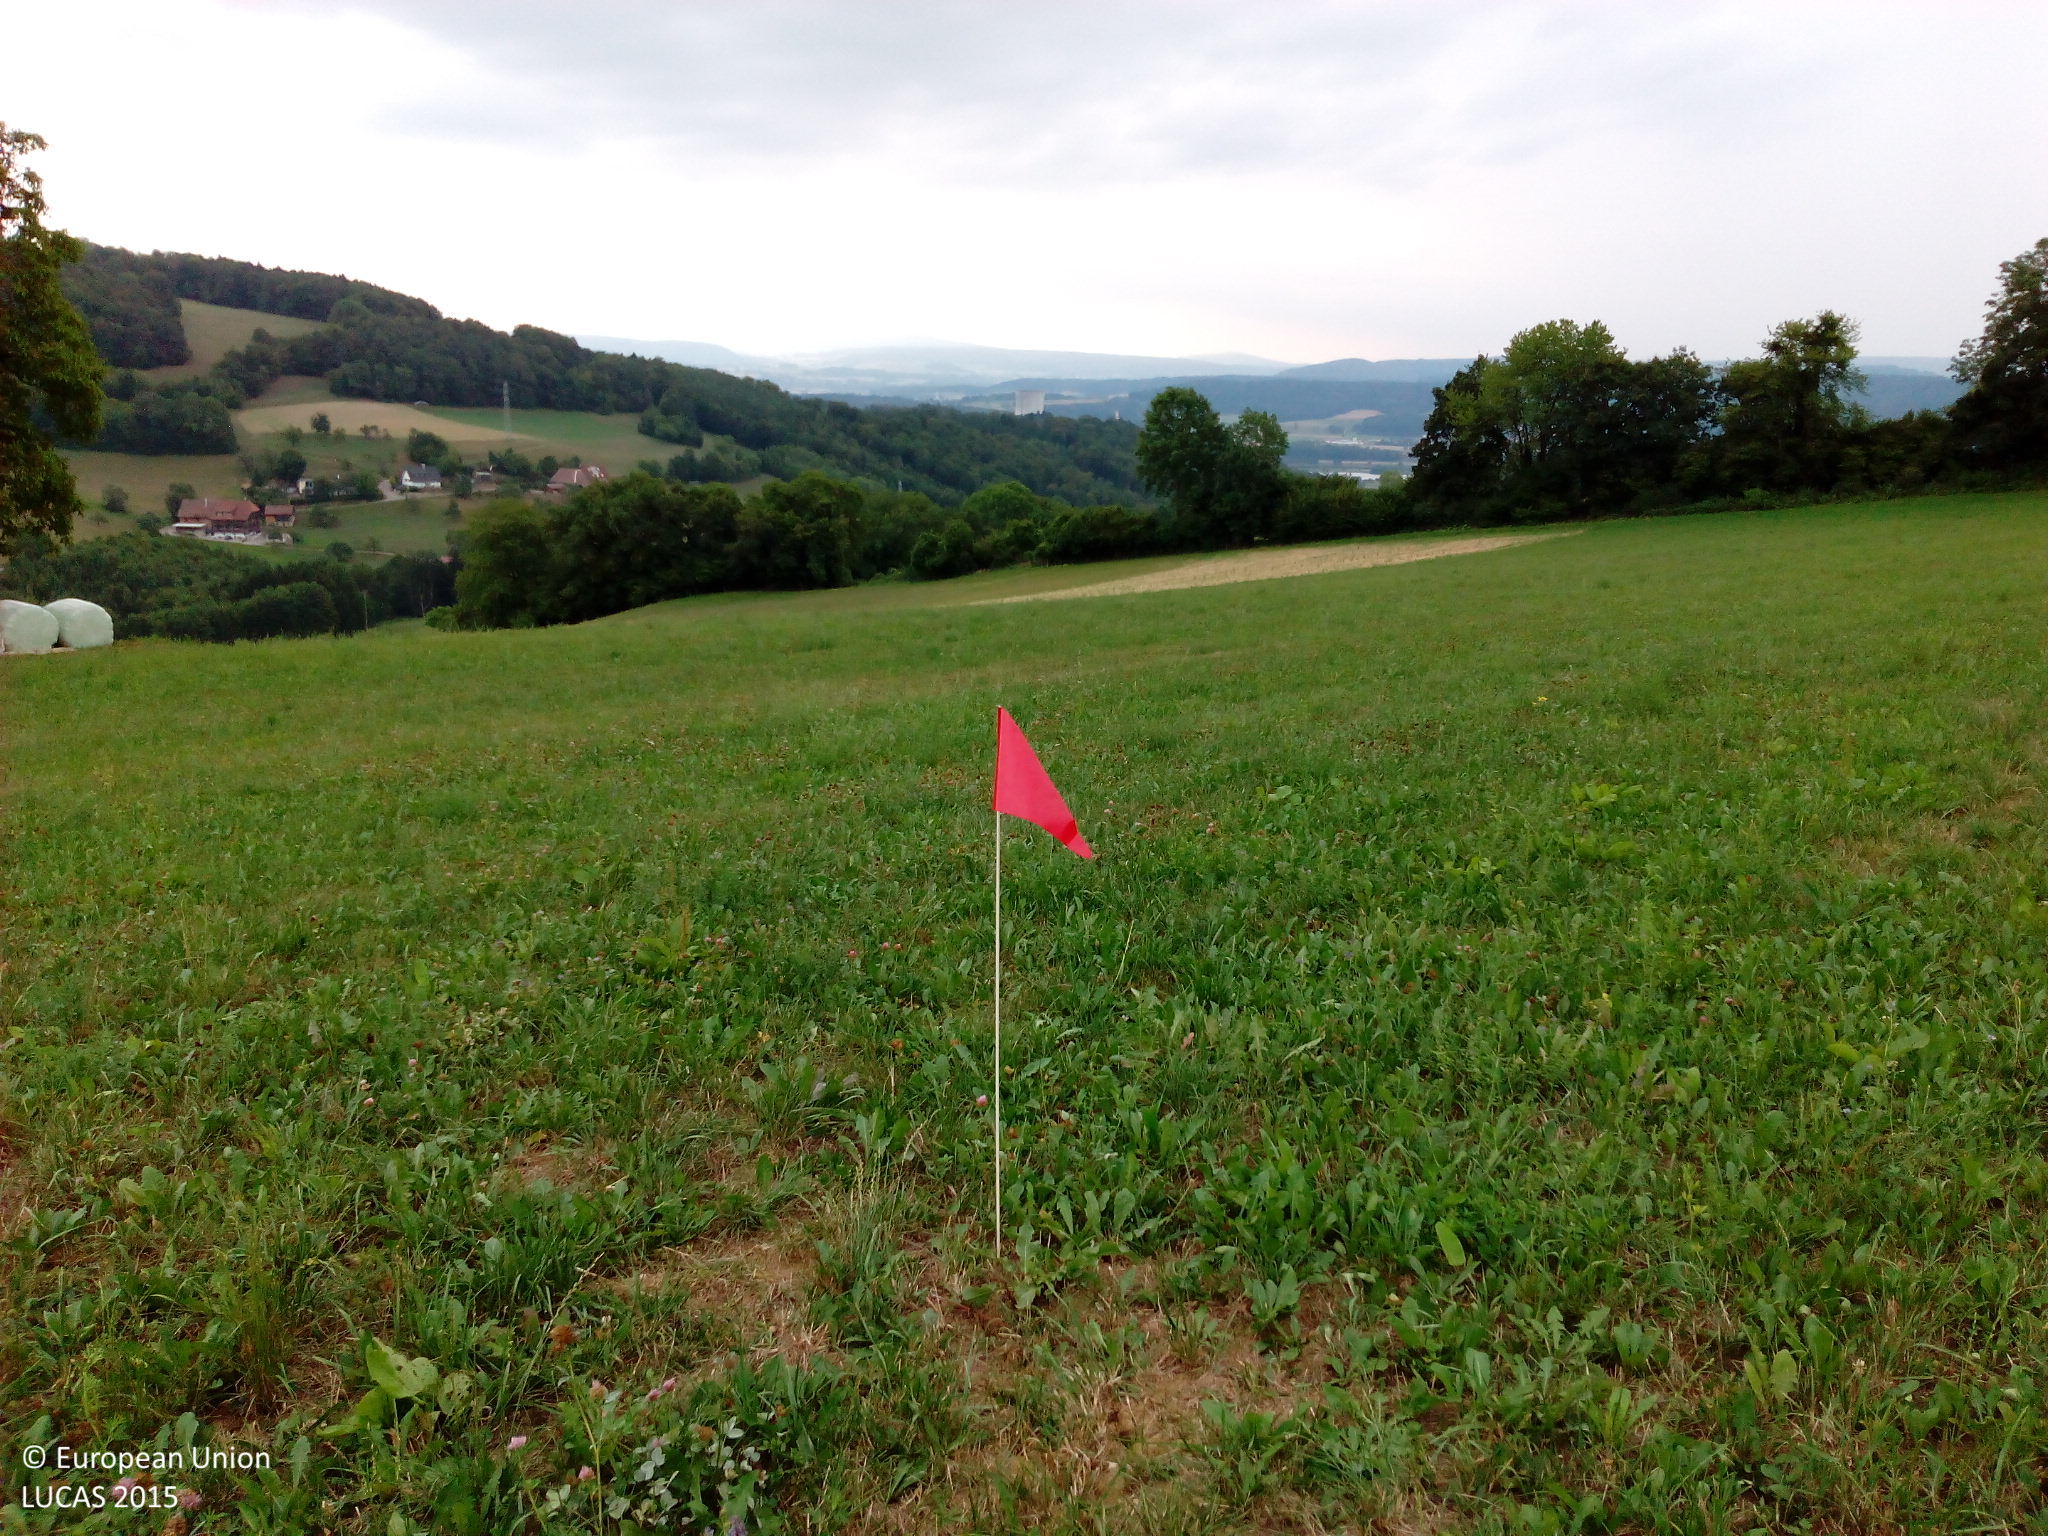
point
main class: Grassland
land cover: Grassland without tree/shrub cover
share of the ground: > 75 %
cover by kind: herbaceous plants 95 %, unconsolidated bare surface 5 %
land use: Agriculture (excluding fallow land and kitchen gardens)
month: August
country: DE
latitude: 47.6320
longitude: 8.1514
